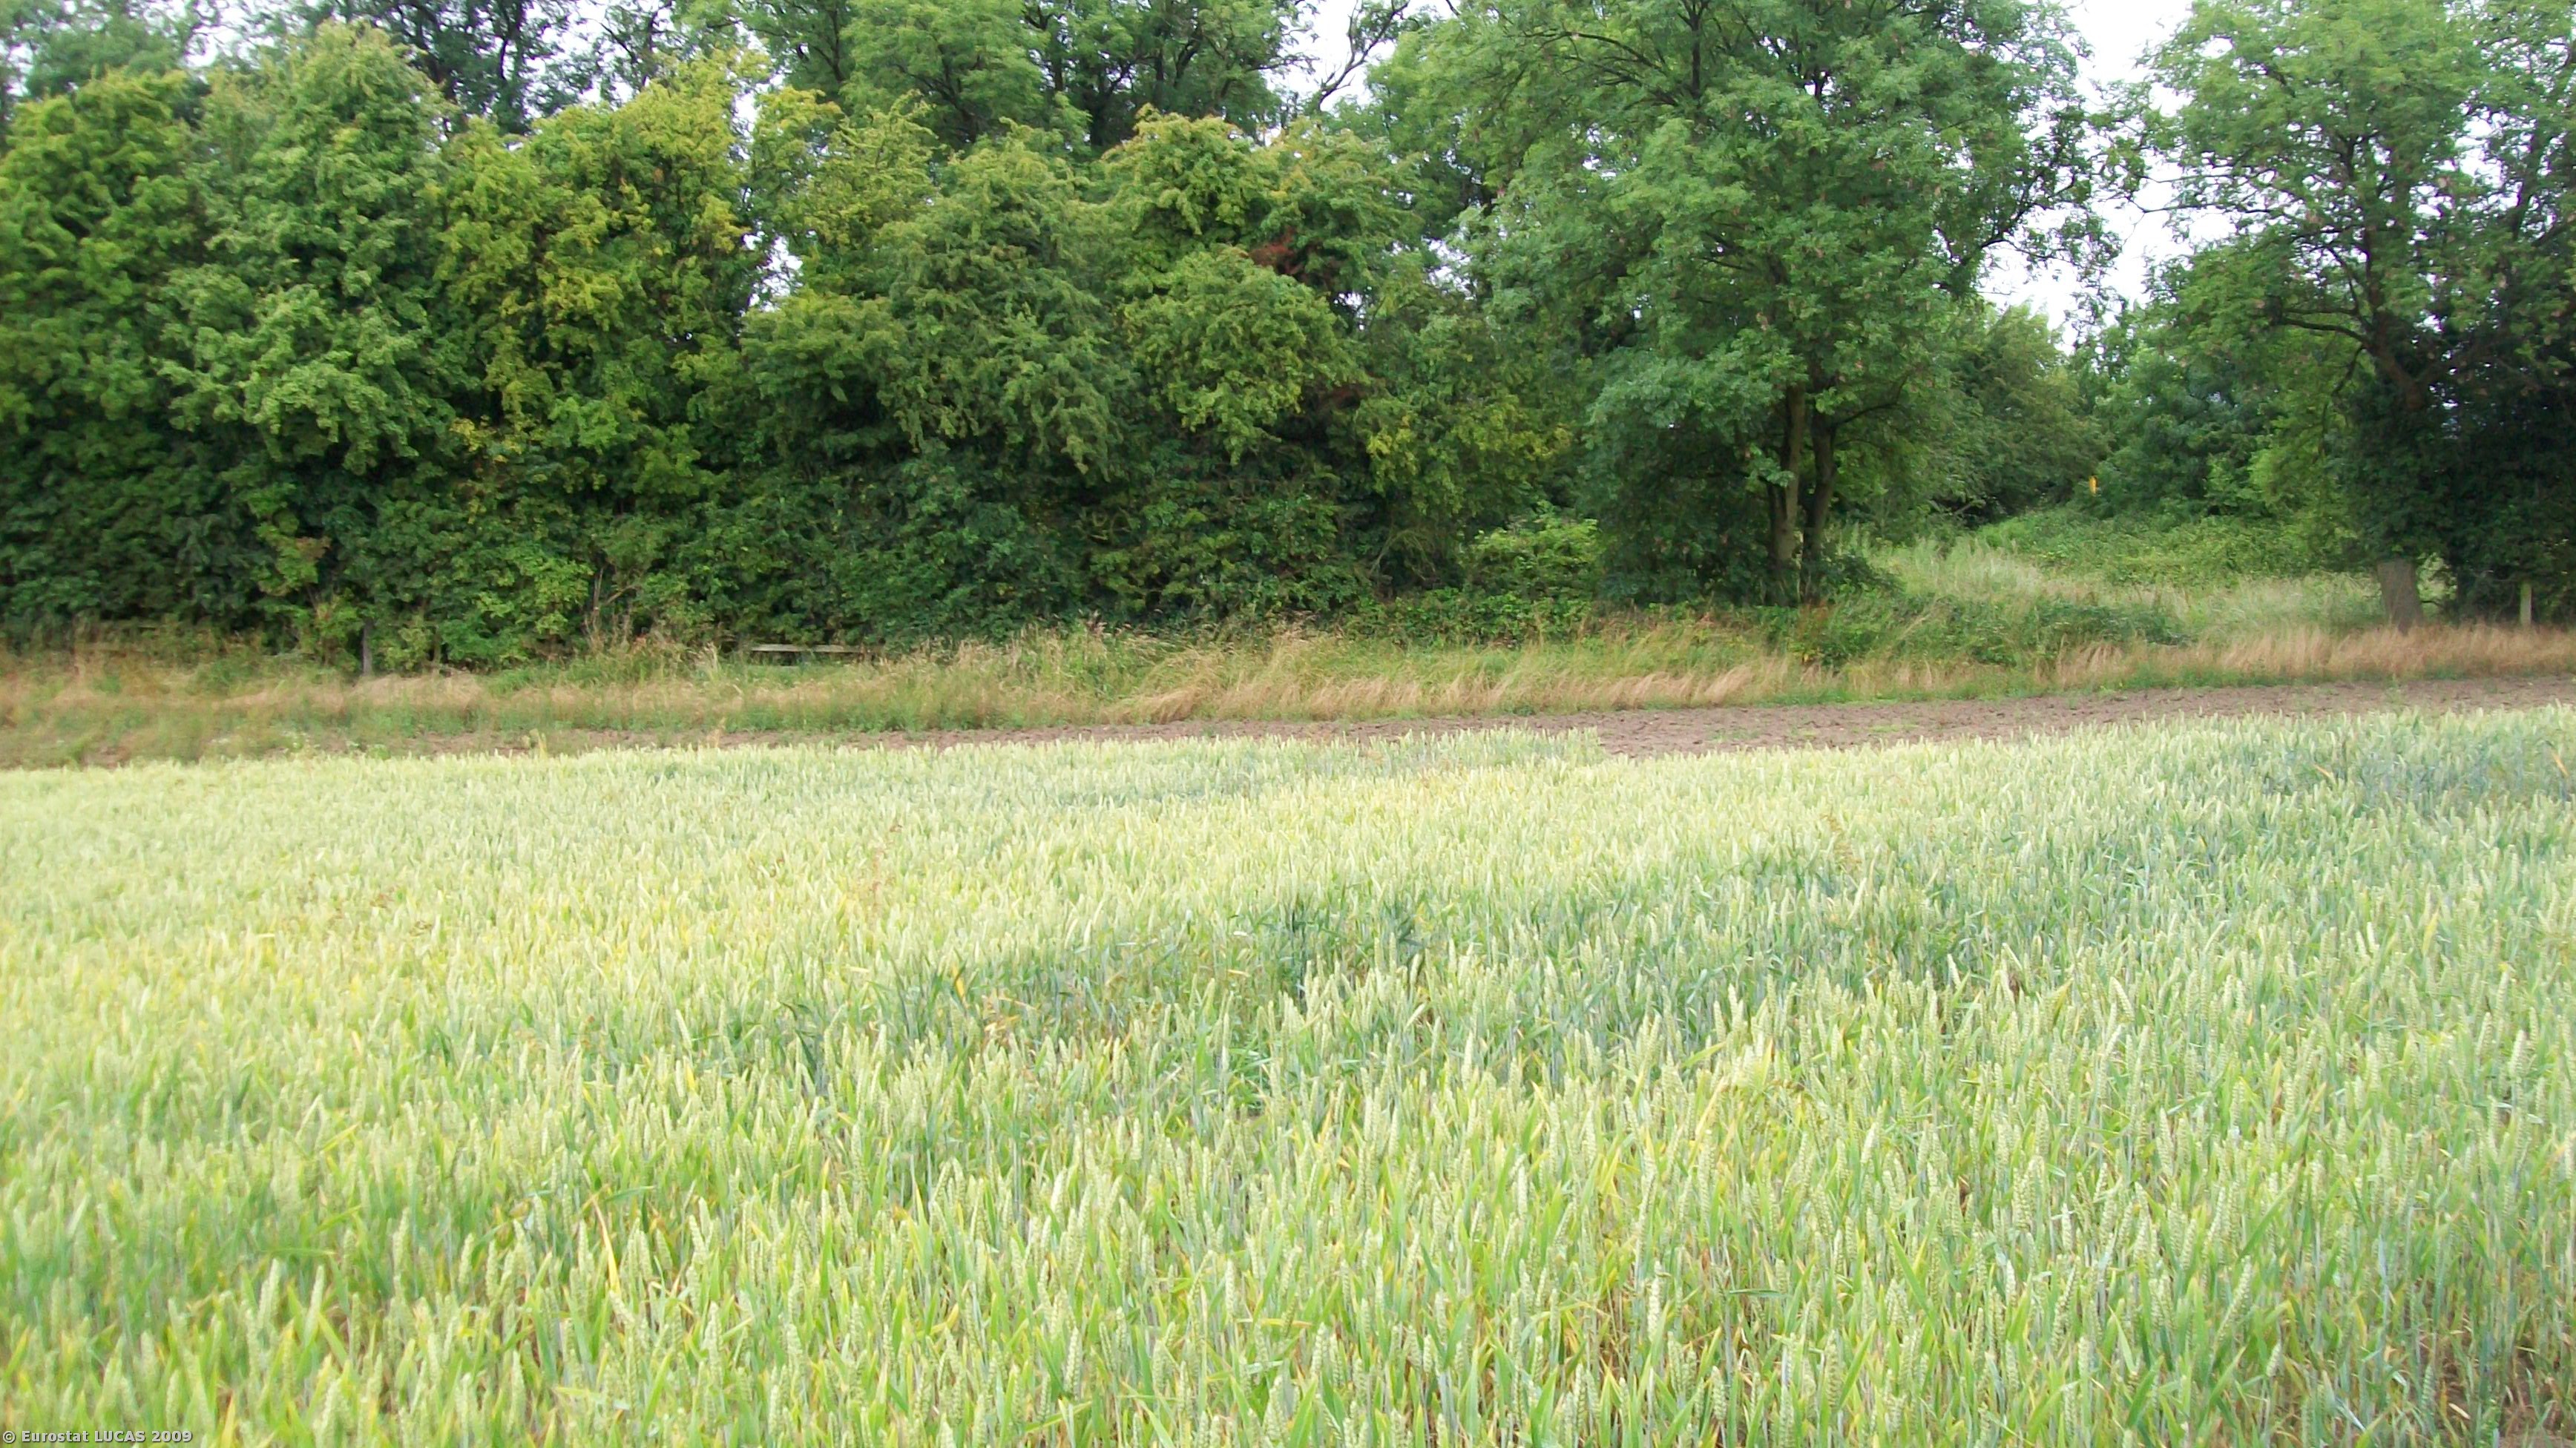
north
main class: Cropland
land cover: Common wheat
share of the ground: > 75 %
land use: Agriculture (excluding fallow land and kitchen gardens)
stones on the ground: 10 - 25 %
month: July
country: GB
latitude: 52.7662
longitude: -1.4470
